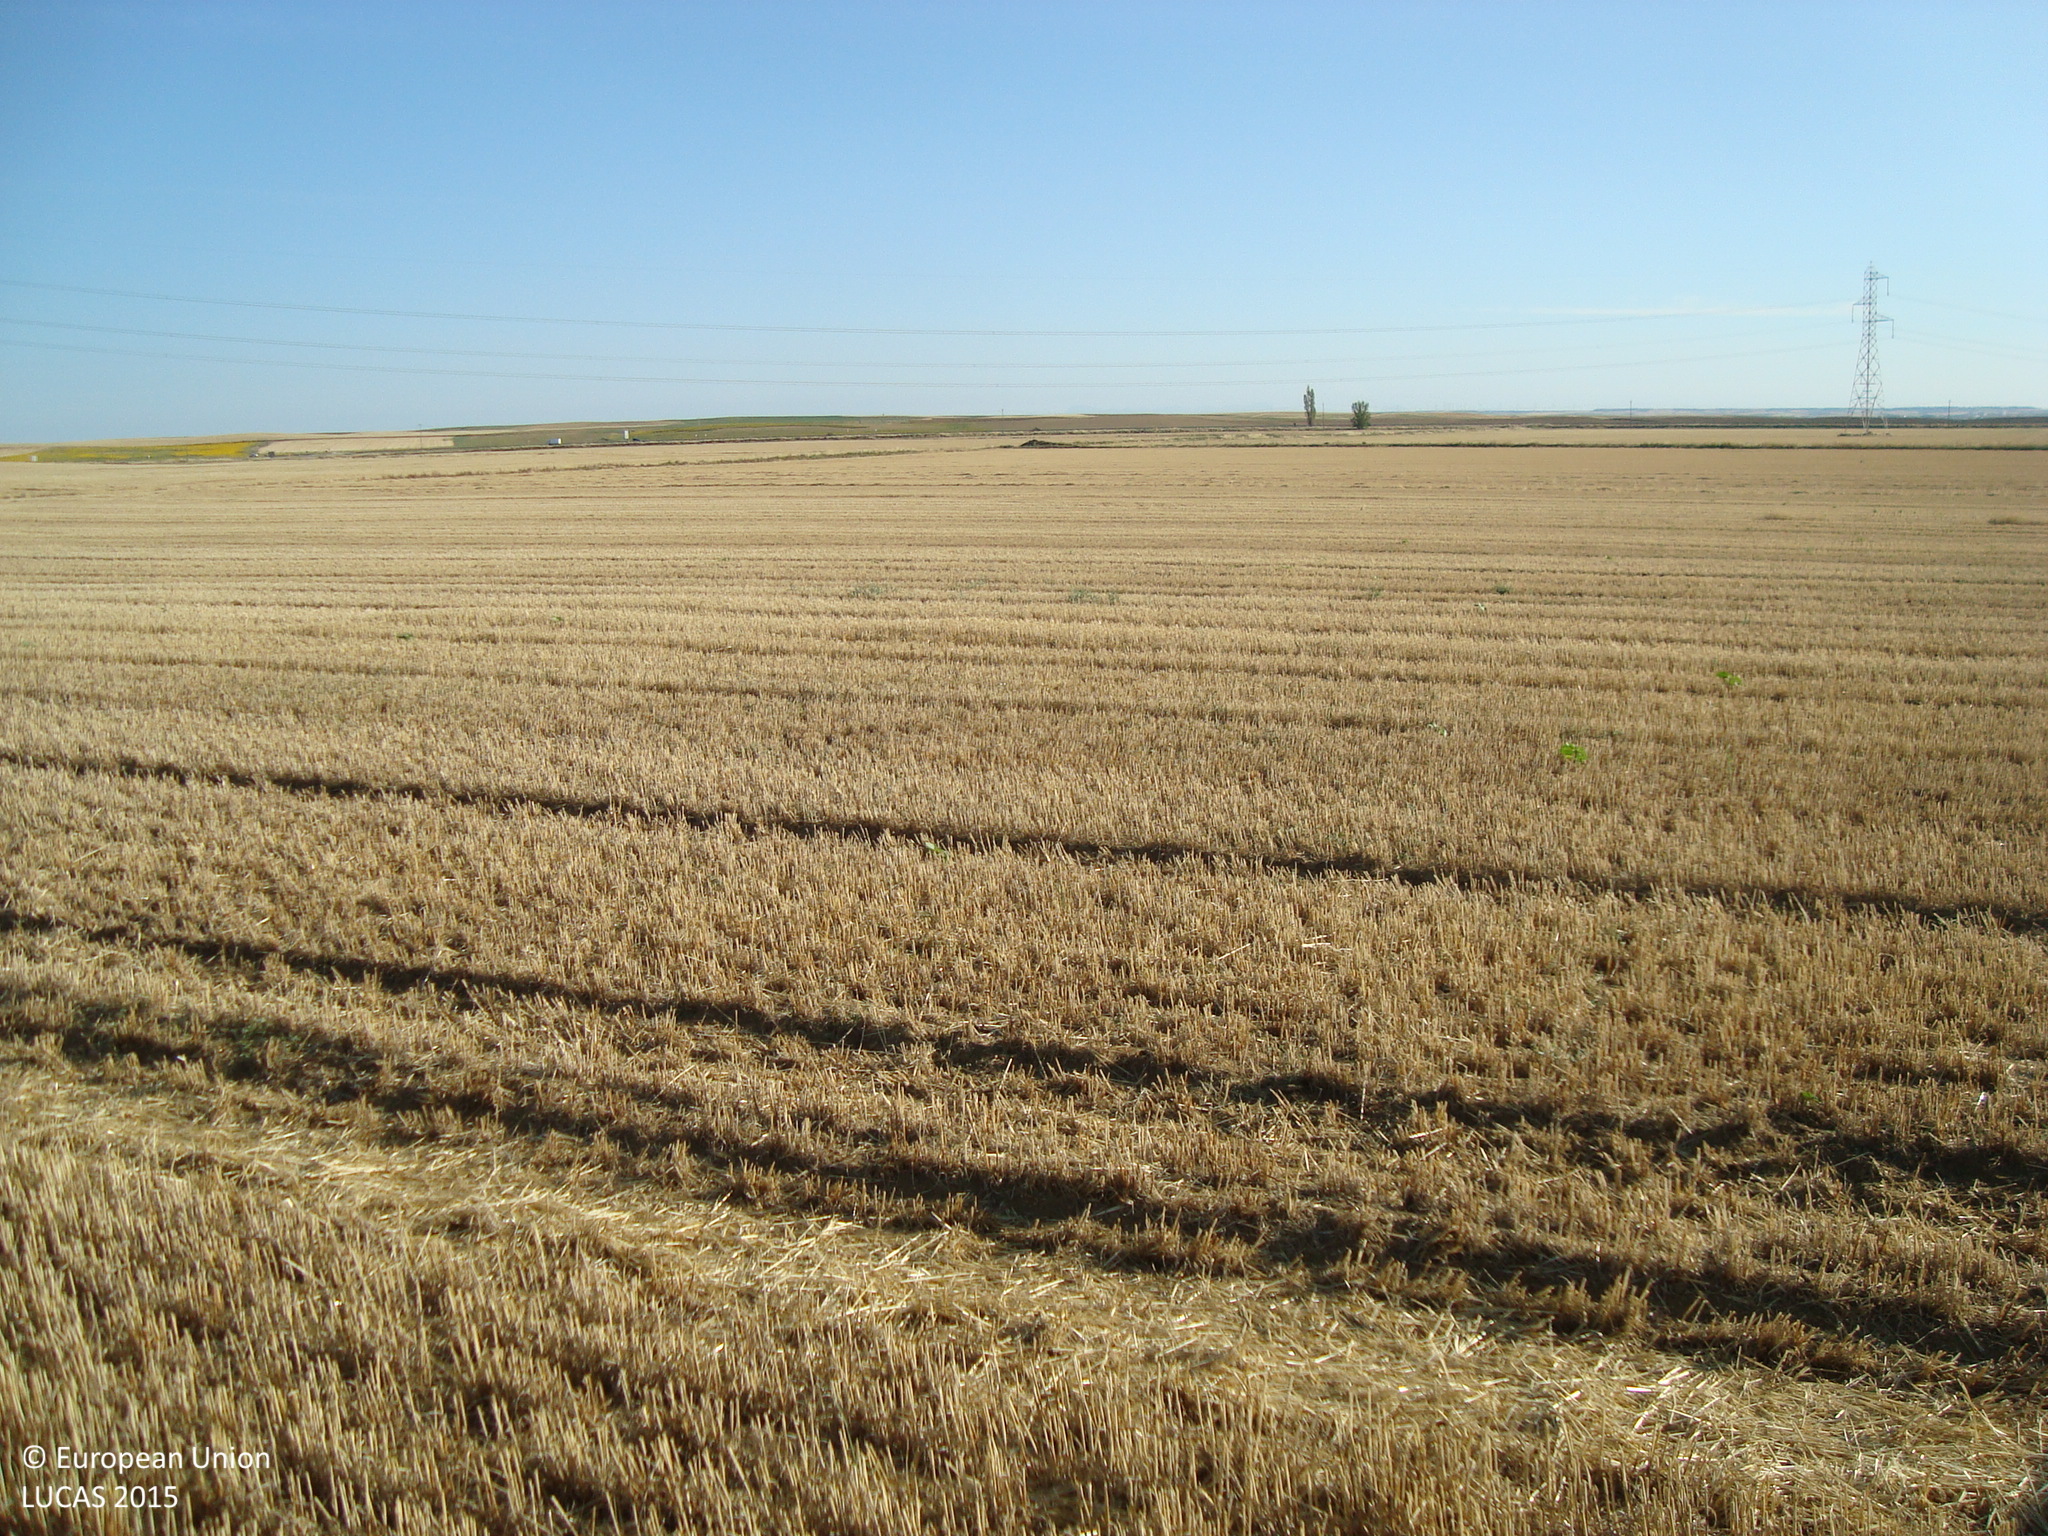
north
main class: Cropland
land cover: Barley
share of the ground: > 75 %
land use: Agriculture (excluding fallow land and kitchen gardens)
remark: Harvested field
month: July
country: ES
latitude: 42.0222
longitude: -4.7723
